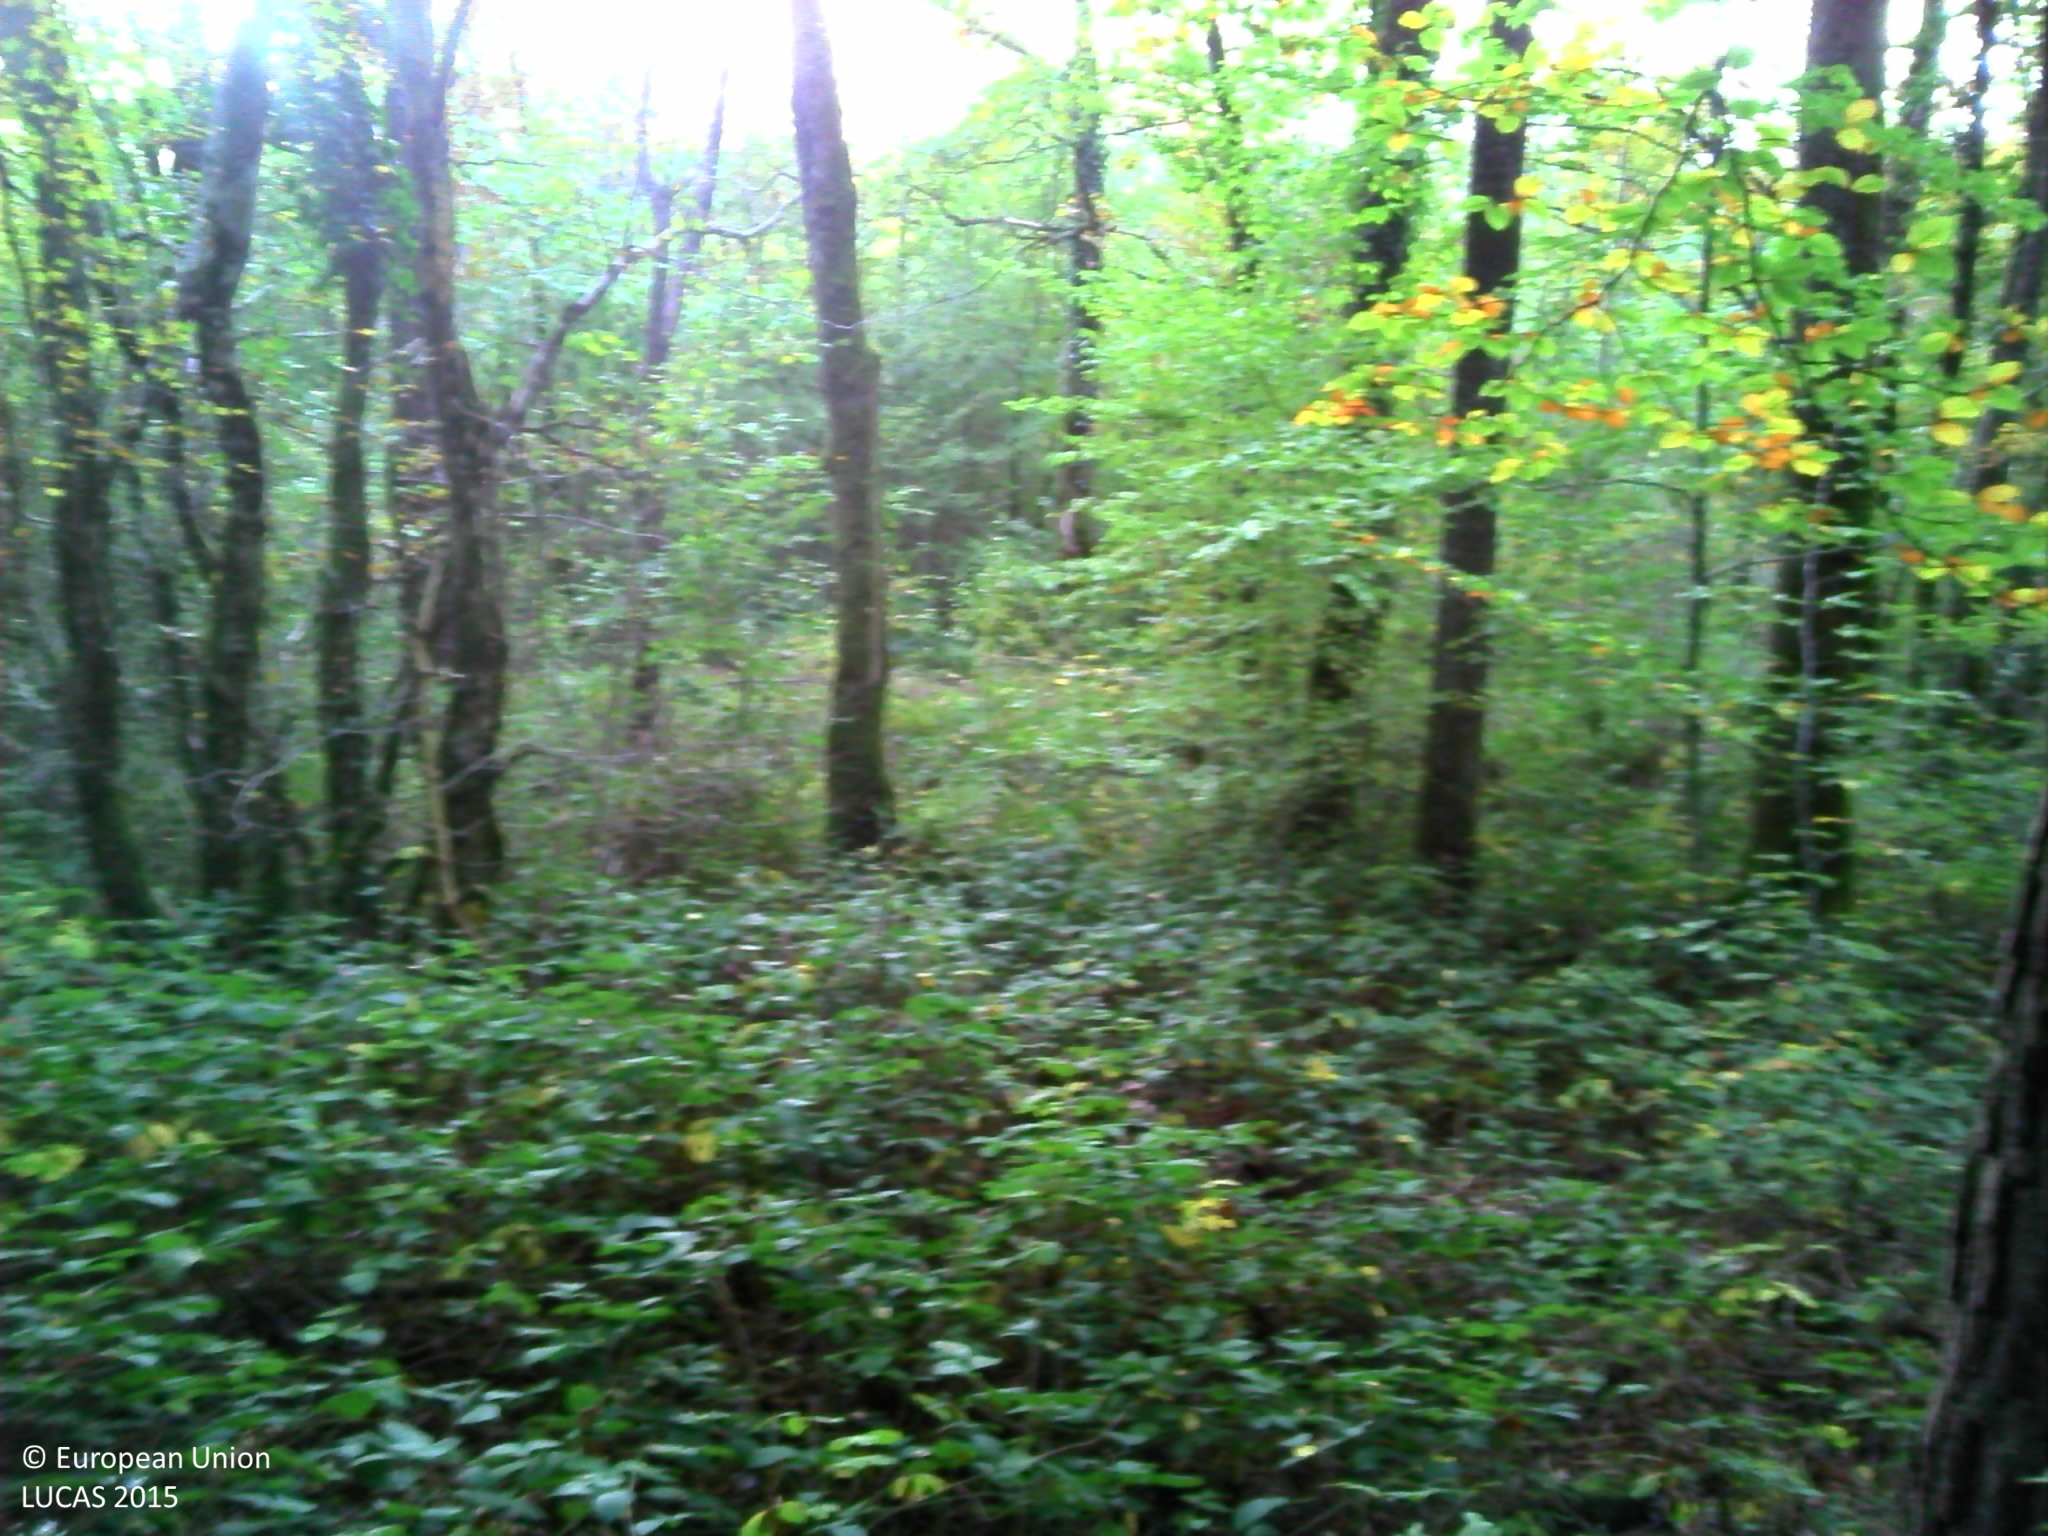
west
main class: Woodland
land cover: Broadleaved woodland
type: beech forest
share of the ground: > 75 %
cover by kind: broadleaved forest trees 90 %, shrubs 5 %, unconsolidated bare surface 5 %
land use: Forestry
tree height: > 5 m
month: October
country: FR
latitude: 47.1080
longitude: 6.0618
